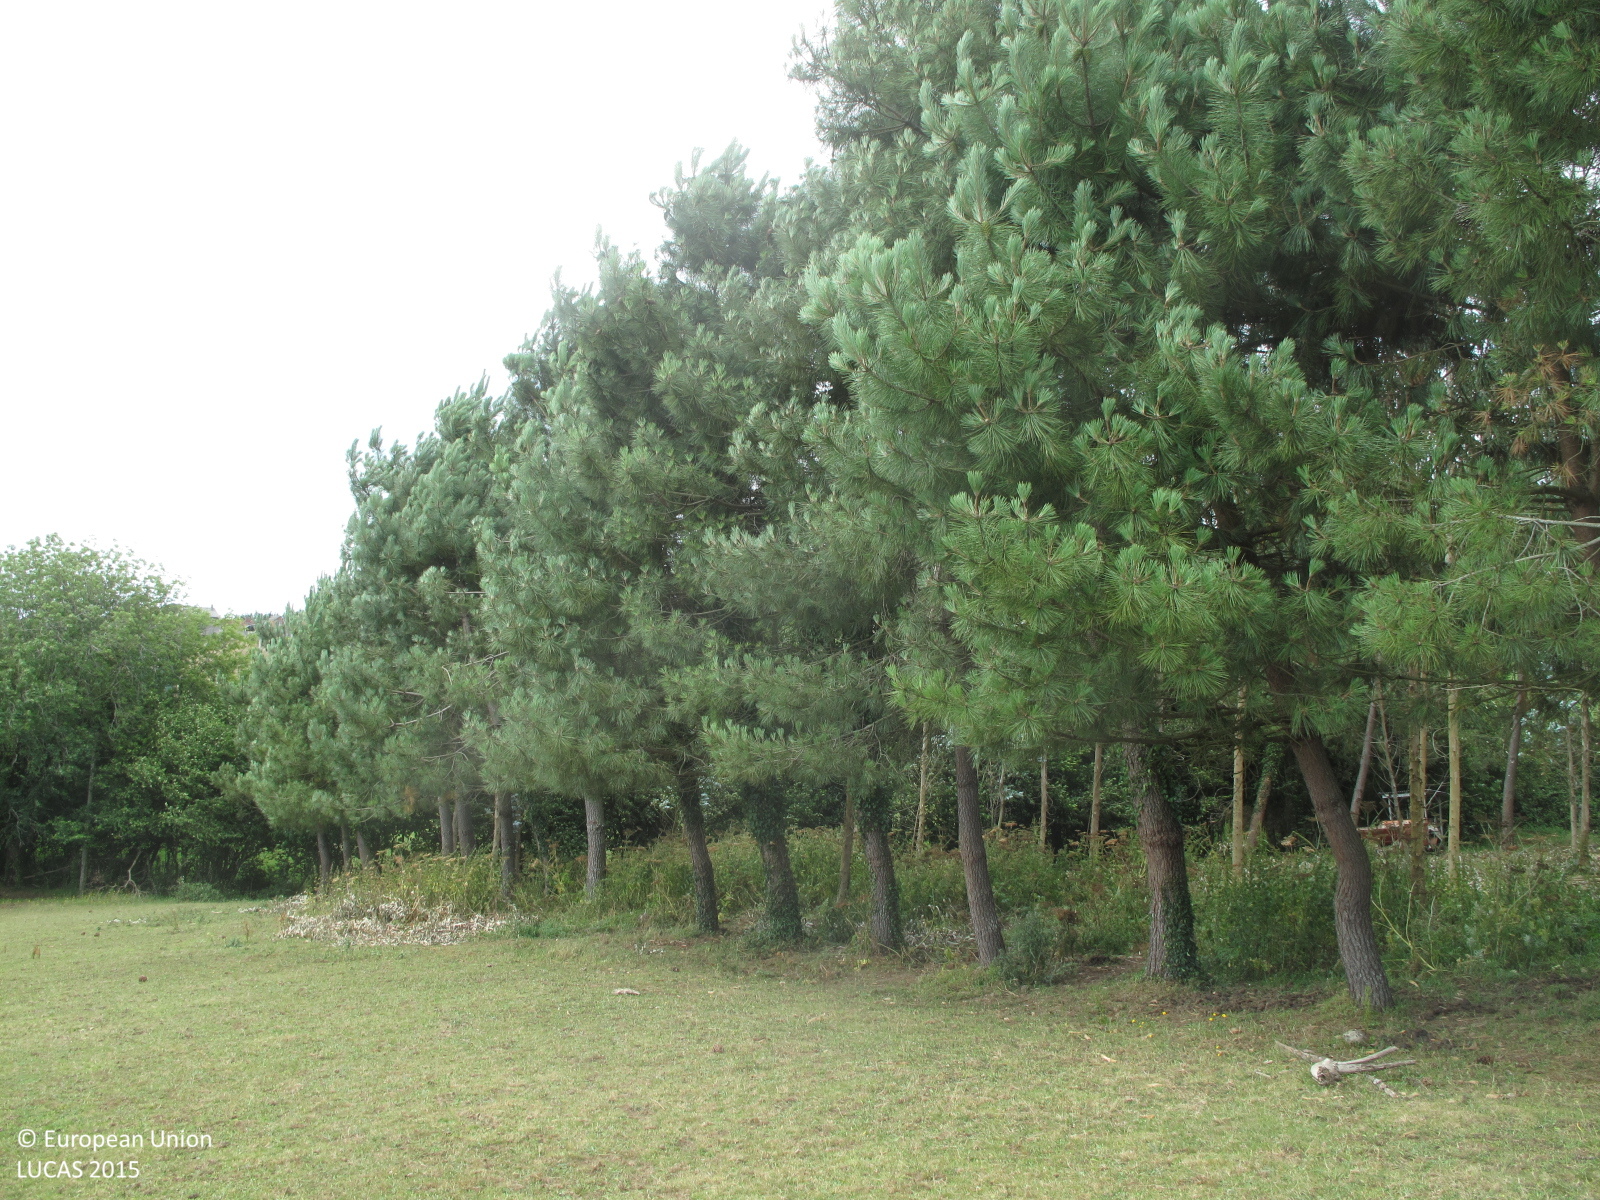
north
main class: Grassland
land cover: Grassland without tree/shrub cover
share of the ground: > 75 %
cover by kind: herbaceous plants 80 %, unconsolidated bare surface 20 %
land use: Agriculture (excluding fallow land and kitchen gardens)
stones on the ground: < 10 %
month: July
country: ES
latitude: 43.2075
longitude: -8.5851
